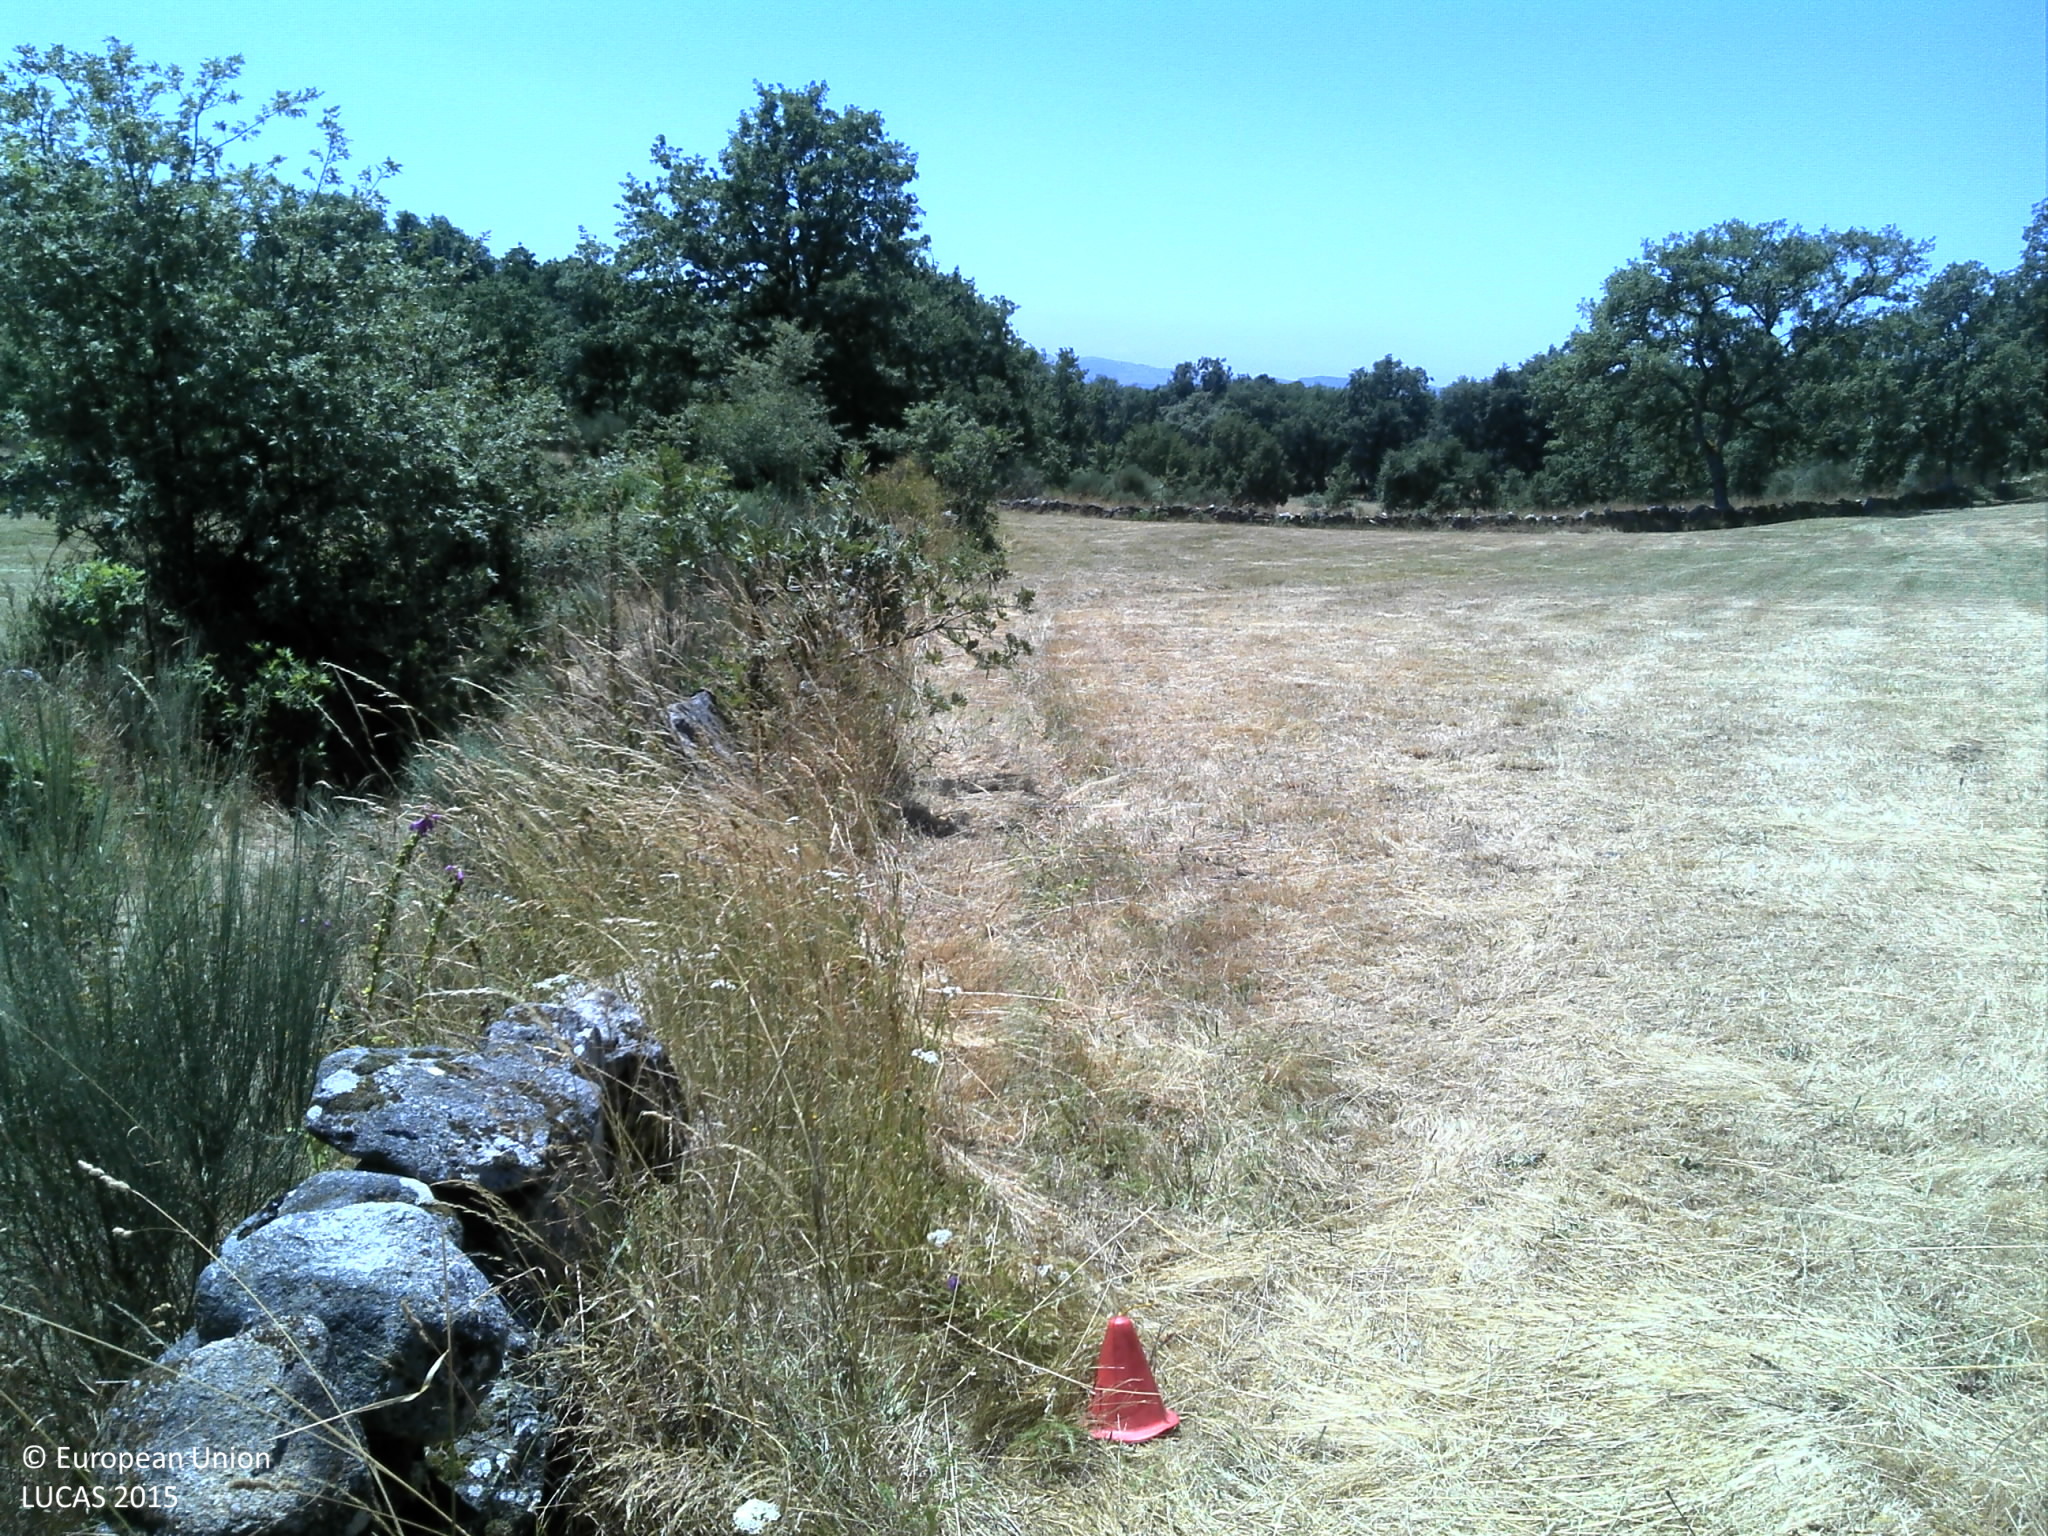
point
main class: Grassland
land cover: Grassland without tree/shrub cover
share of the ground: > 75 %
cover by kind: herbaceous plants 90 %, unconsolidated bare surface 10 %
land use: Agriculture (excluding fallow land and kitchen gardens)
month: July
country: PT
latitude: 41.7696
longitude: -7.6627
